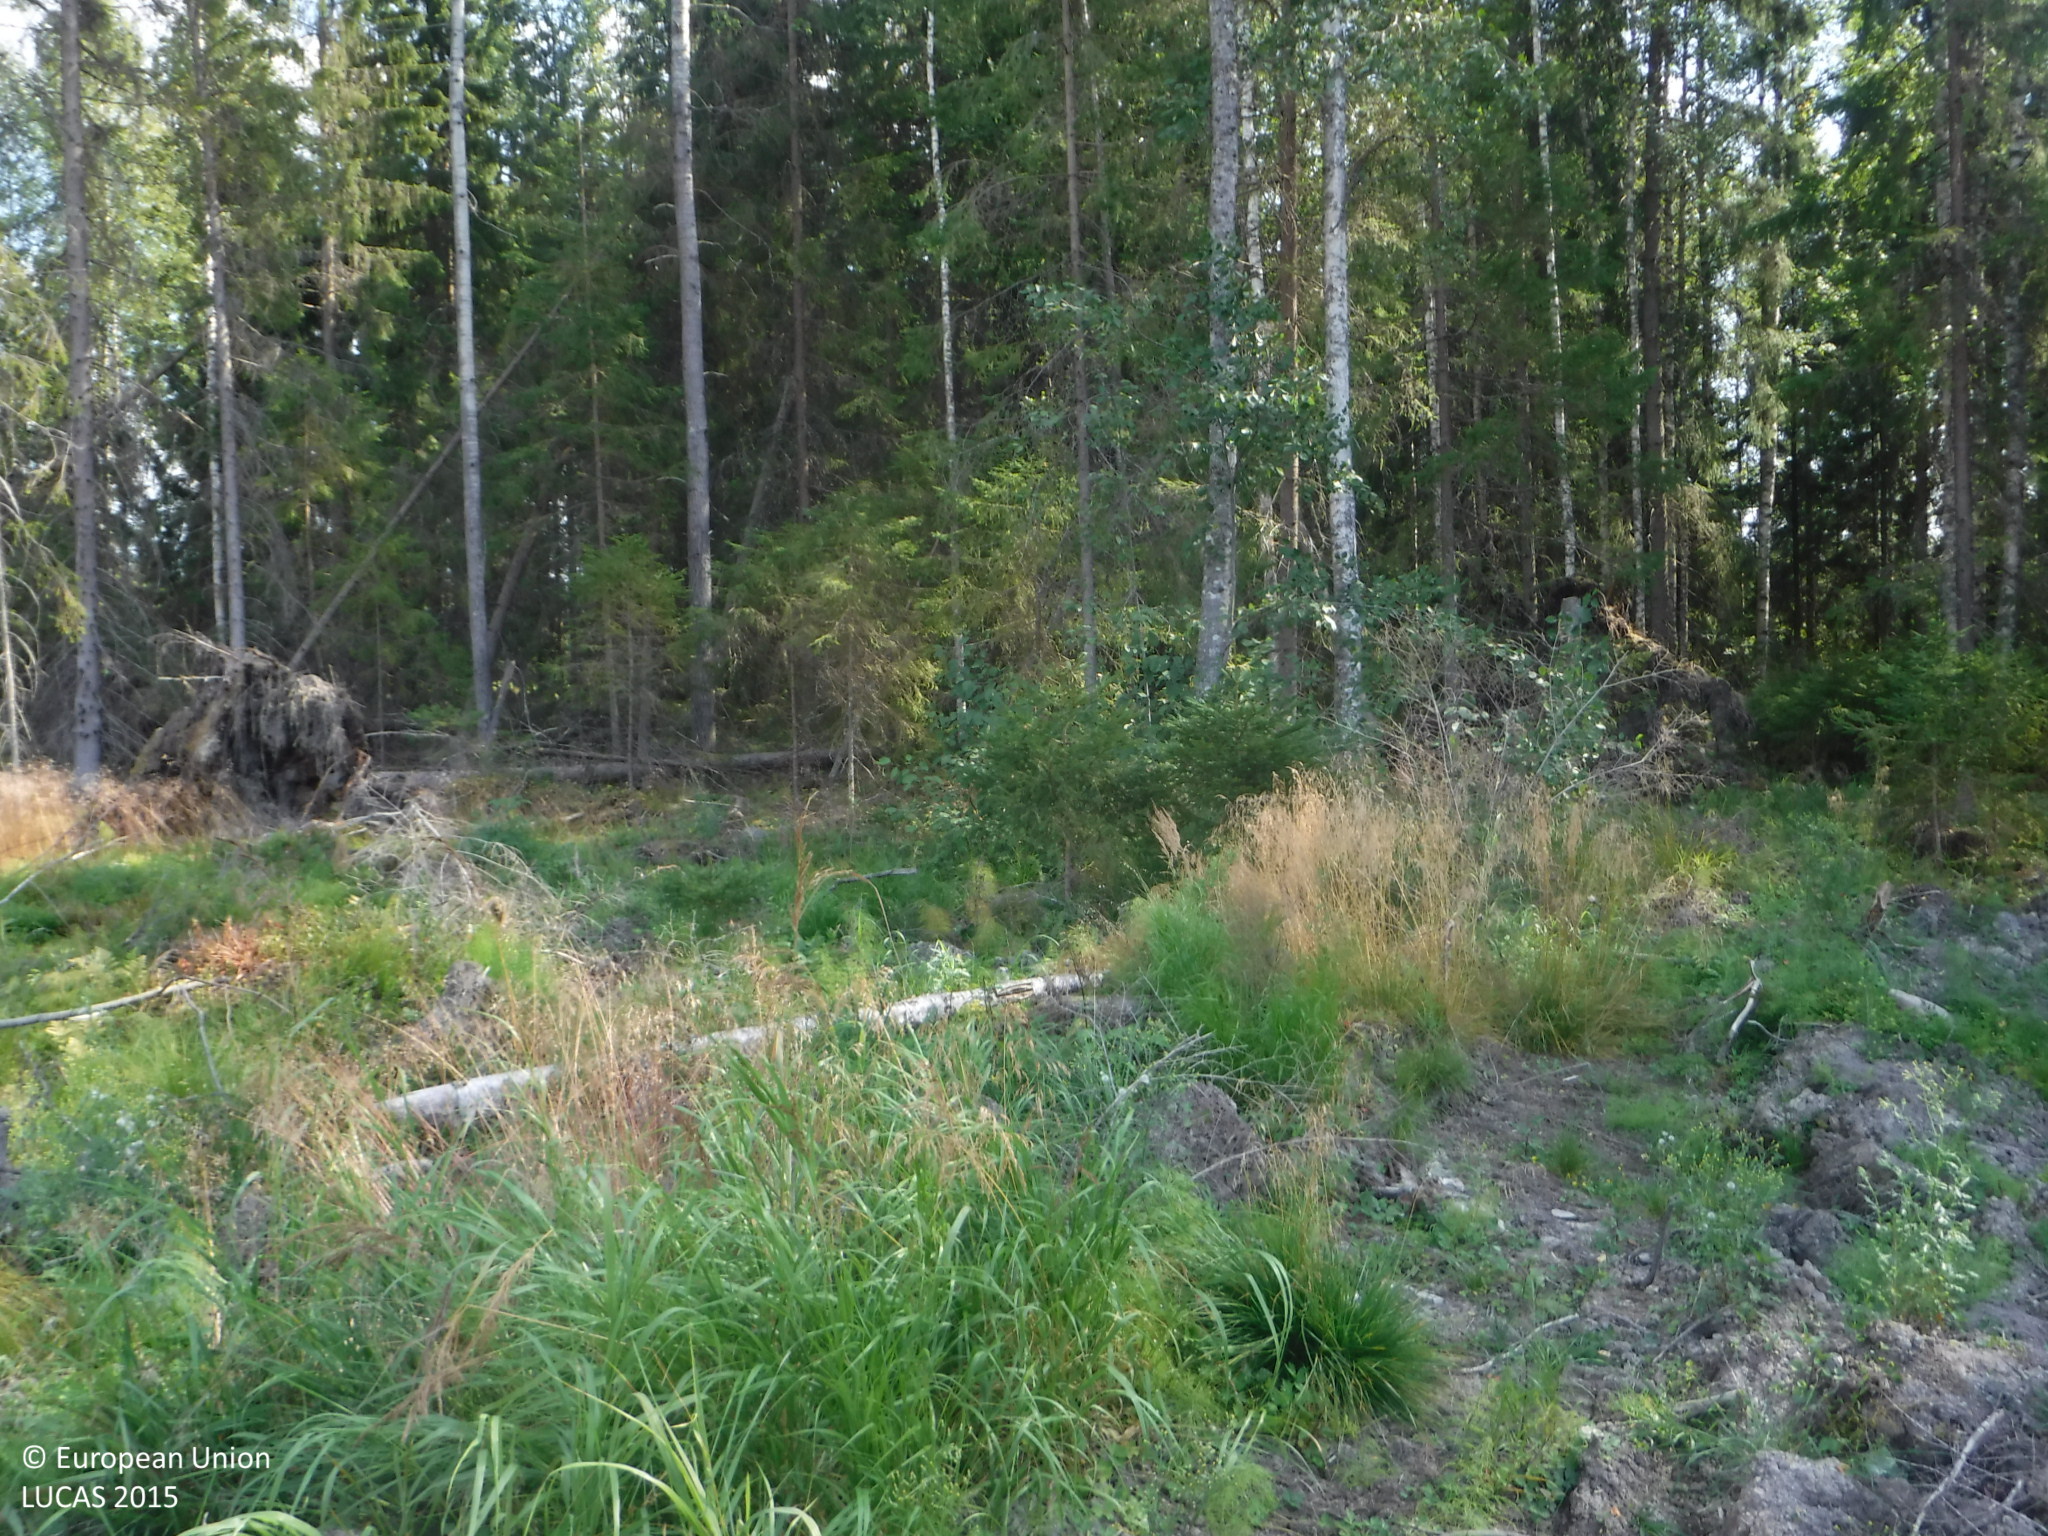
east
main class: Grassland
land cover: Spontaneously vegetated surfaces
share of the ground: 50 - 75 %
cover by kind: herbaceous plants 50 %, unconsolidated bare surface 35 %, shrubs 5 %
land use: Forestry
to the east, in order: Spontaneously vegetated surfaces; Spruce dominated coniferous woodland; Groves; Ditches and canals; Grass margins; Common wheat; Grass margins; Ditches and canals; Temporary grasslands; Ditches and canals; Broadleaved woodland
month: August
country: FI
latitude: 61.2039
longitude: 23.1966
